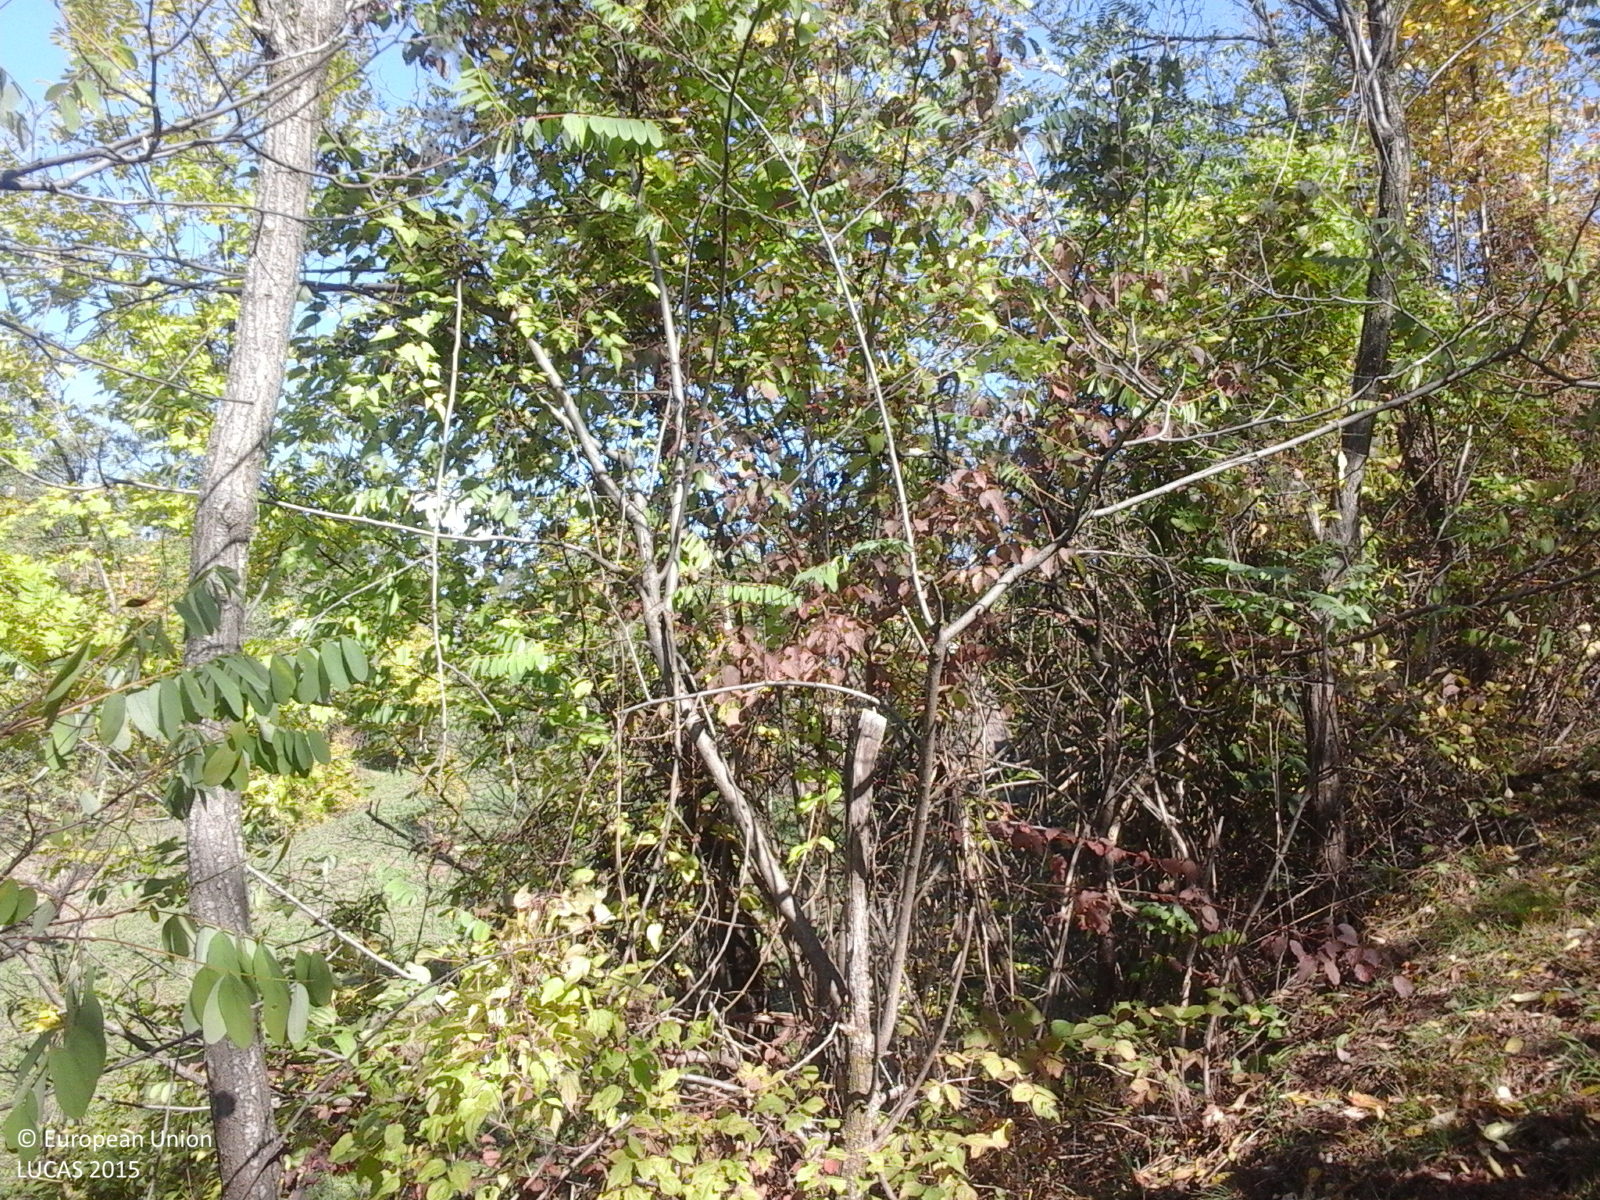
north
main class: Grassland
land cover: Grassland with sparse tree/shrub cover
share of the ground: > 75 %
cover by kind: herbaceous plants 95 %, broadleaved forest trees 5 %
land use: Agriculture (excluding fallow land and kitchen gardens)
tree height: > 5 m
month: October
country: RO
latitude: 45.2189
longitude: 25.7028
